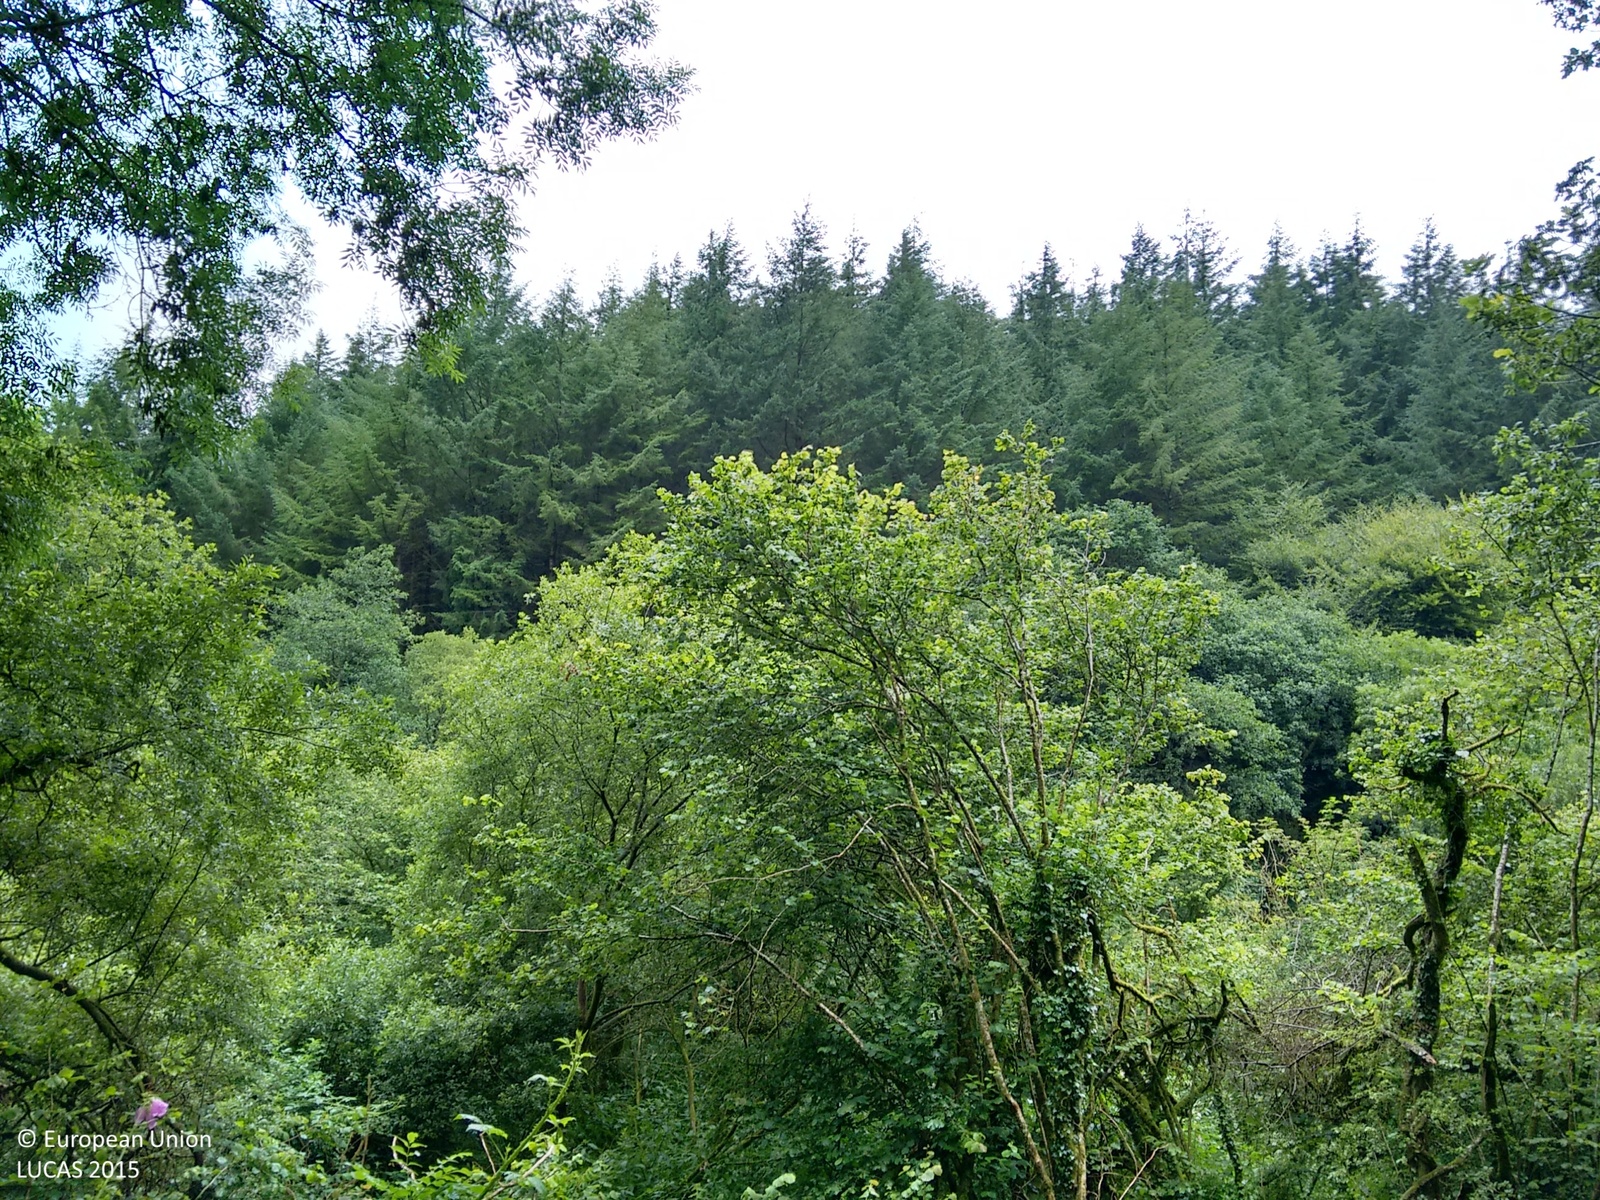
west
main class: Woodland
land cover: Spruce dominated coniferous woodland
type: exotic forest
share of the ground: > 75 %
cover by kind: coniferous forest trees 90 %, shrubs 10 %
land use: Semi-natural and natural areas not in use
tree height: > 5 m
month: August
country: GB
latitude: 51.9001
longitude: -4.5083
